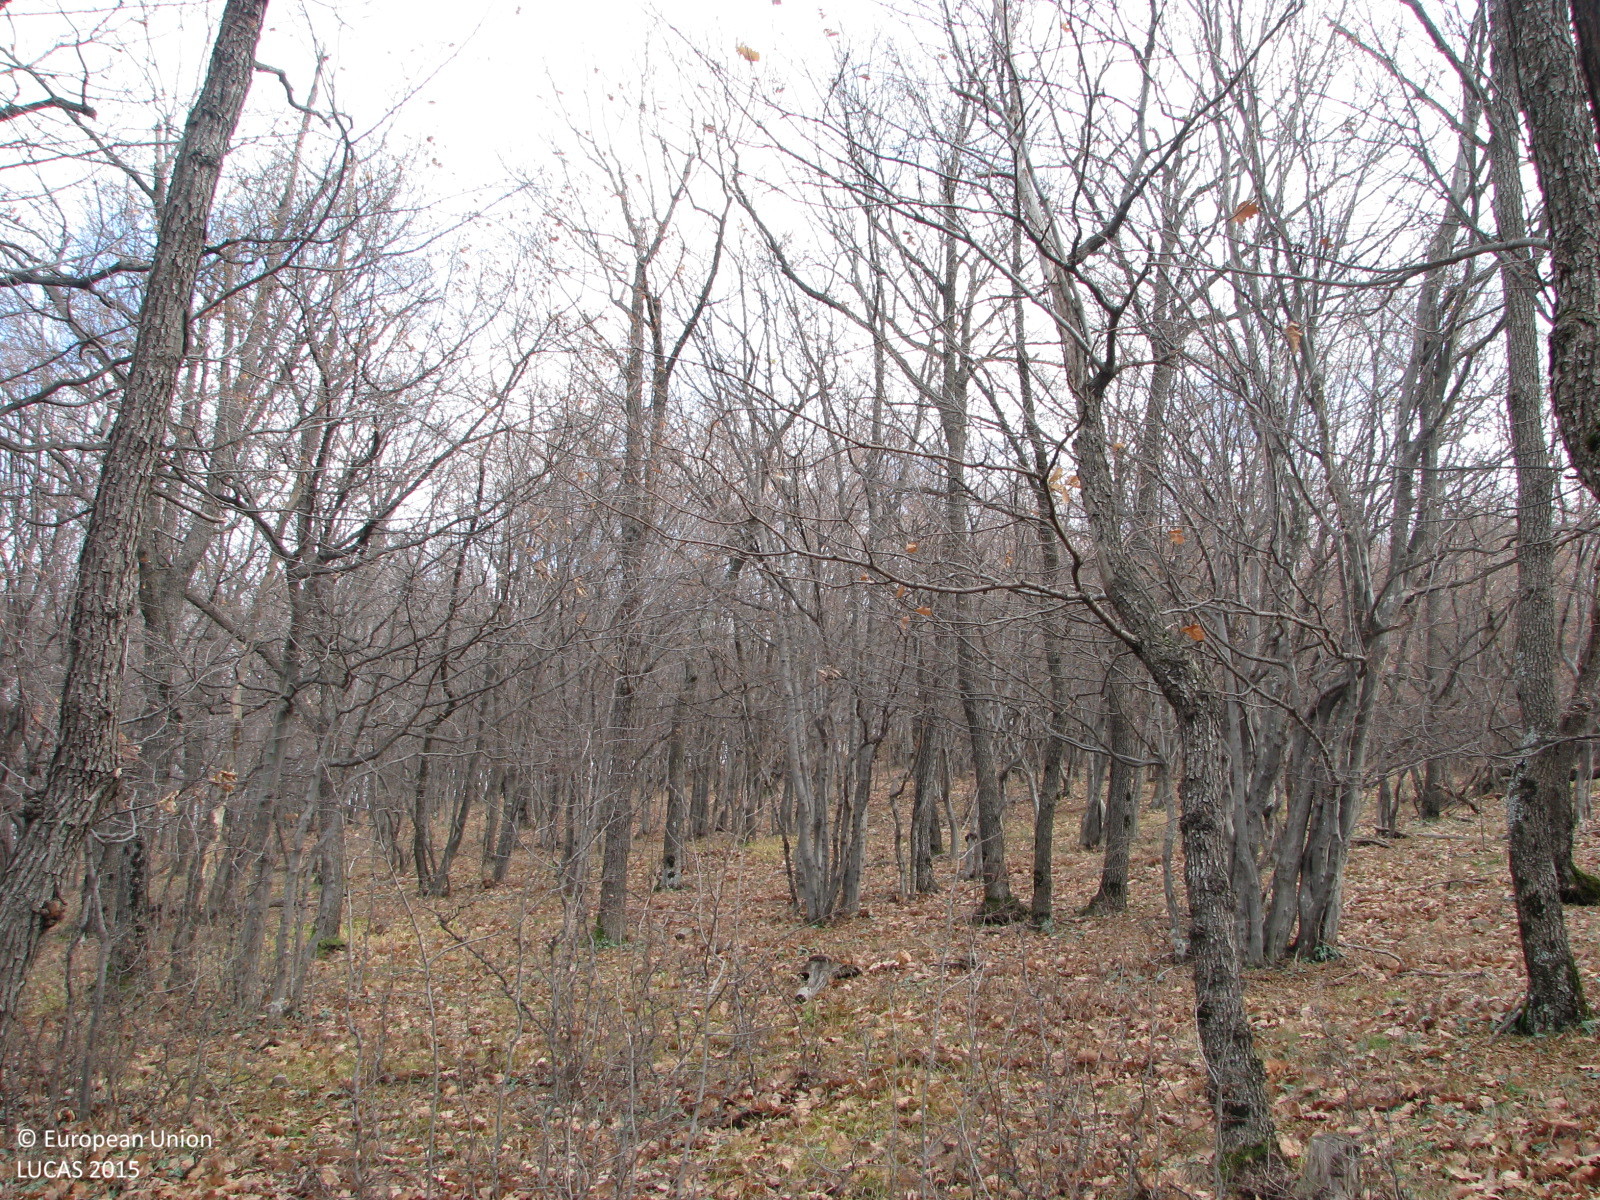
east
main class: Woodland
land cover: Broadleaved woodland
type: mesophytic deciduous forest
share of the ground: > 75 %
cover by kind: broadleaved forest trees 85 %, herbaceous plants 10 %, unconsolidated bare surface 5 %
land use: Semi-natural and natural areas not in use
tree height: < 5 m
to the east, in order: Broadleaved woodland; Grass margins; Tracks; Grass margins; Broadleaved woodland; Rocks and stones; Inland fresh water bodies; Rocks and stones
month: December
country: BG
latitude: 42.5428
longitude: 24.0844
